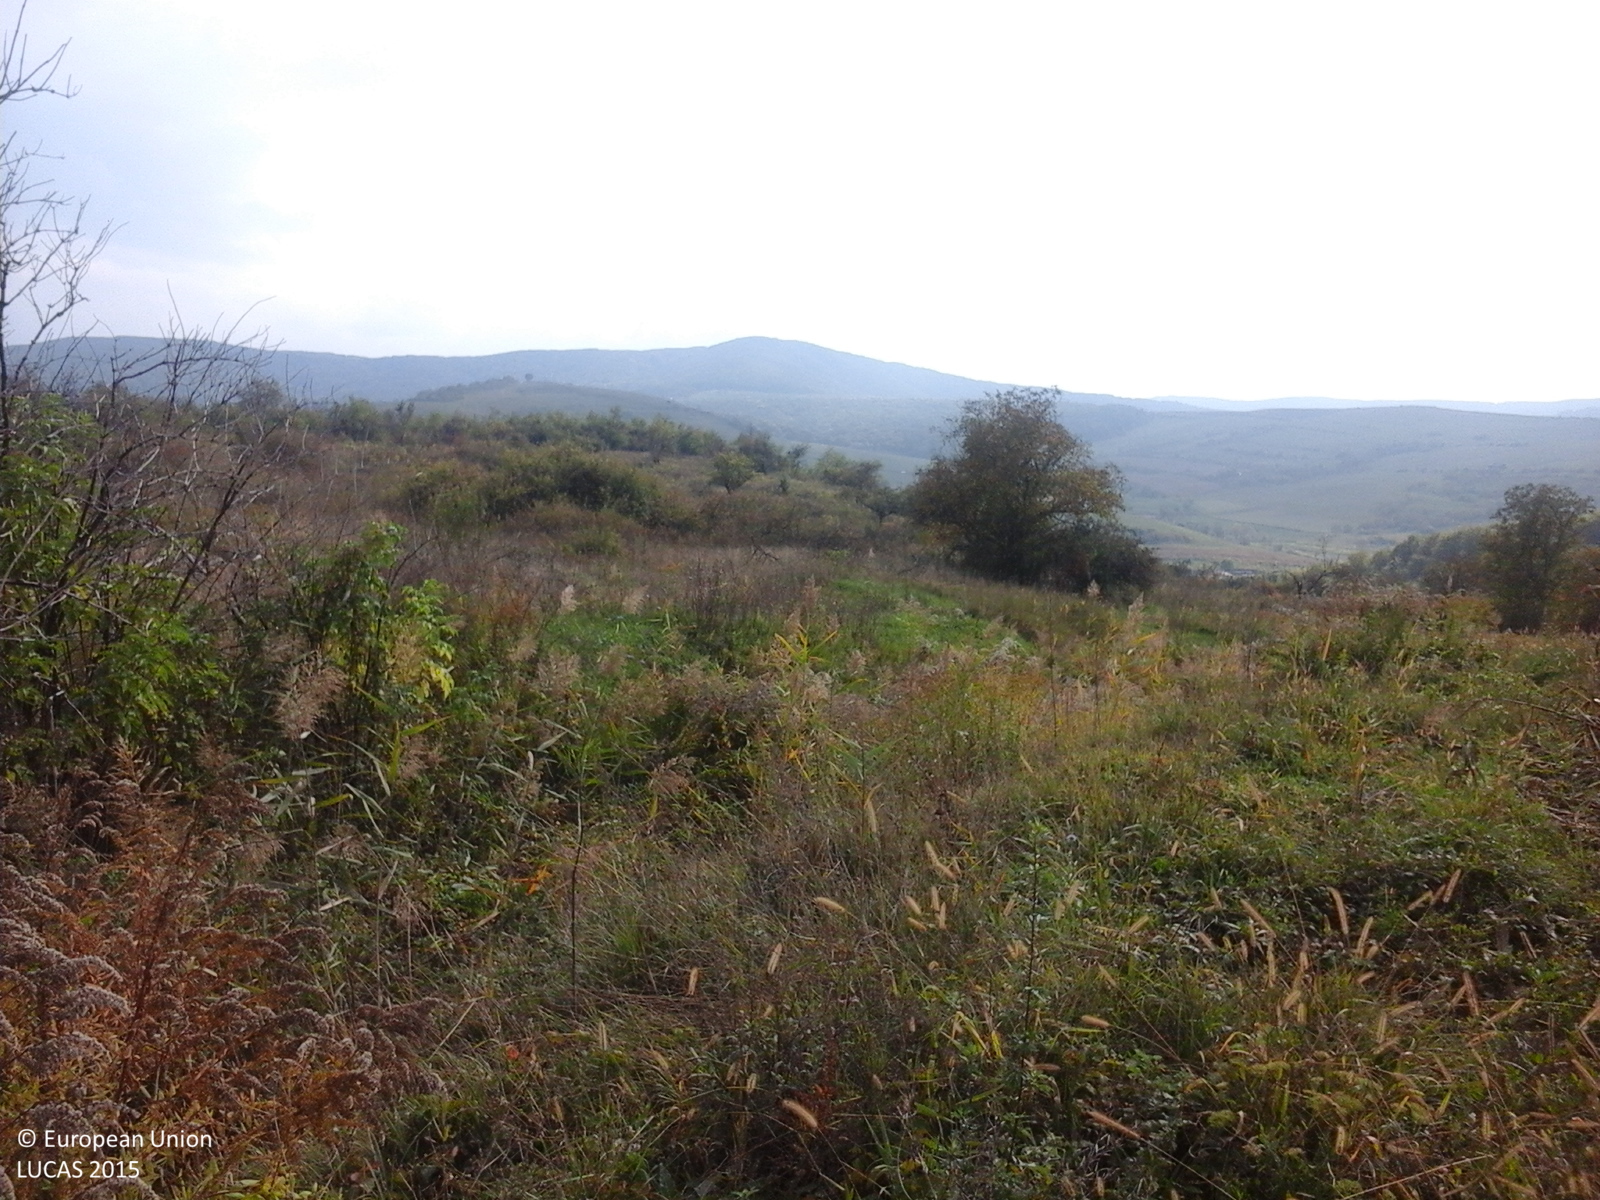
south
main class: Grassland
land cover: Spontaneously vegetated surfaces
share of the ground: > 75 %
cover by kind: herbaceous plants 100 %
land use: Fallow land
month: October
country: RO
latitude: 46.2105
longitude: 24.2732
